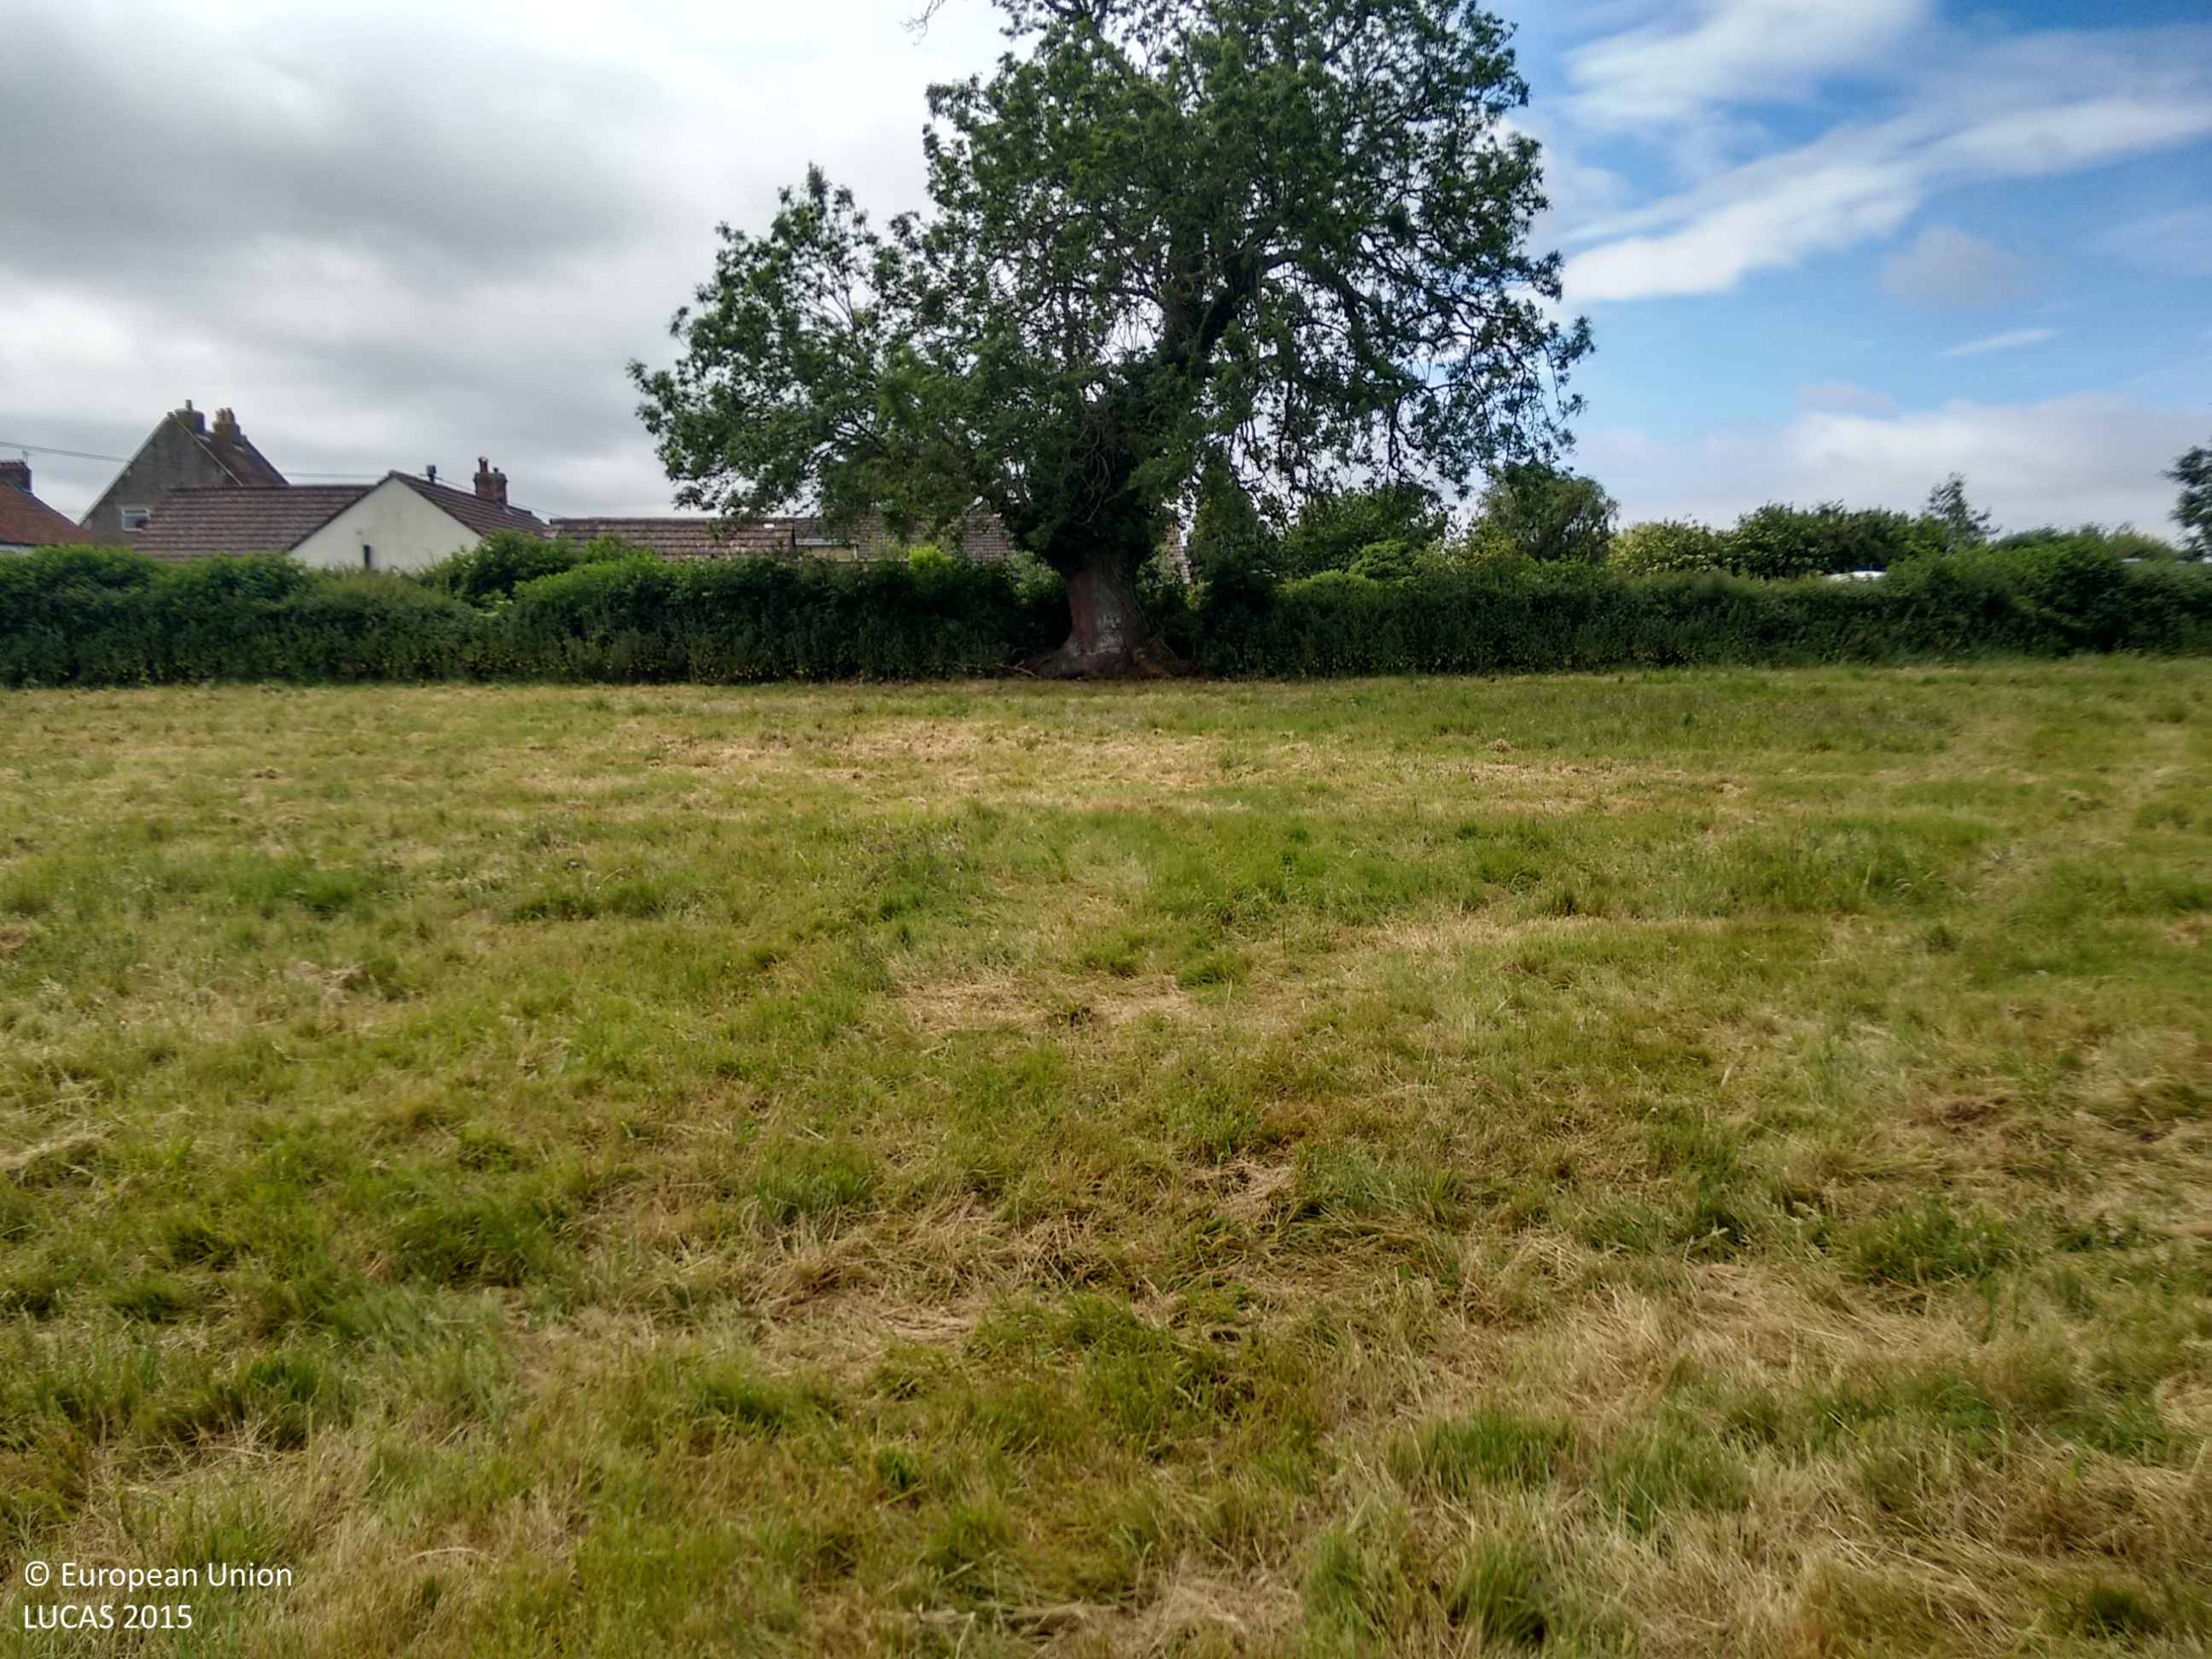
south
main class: Grassland
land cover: Grassland without tree/shrub cover
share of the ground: > 75 %
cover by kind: herbaceous plants 100 %
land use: Agriculture (excluding fallow land and kitchen gardens)
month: June
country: GB
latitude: 51.2217
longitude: -2.3344
